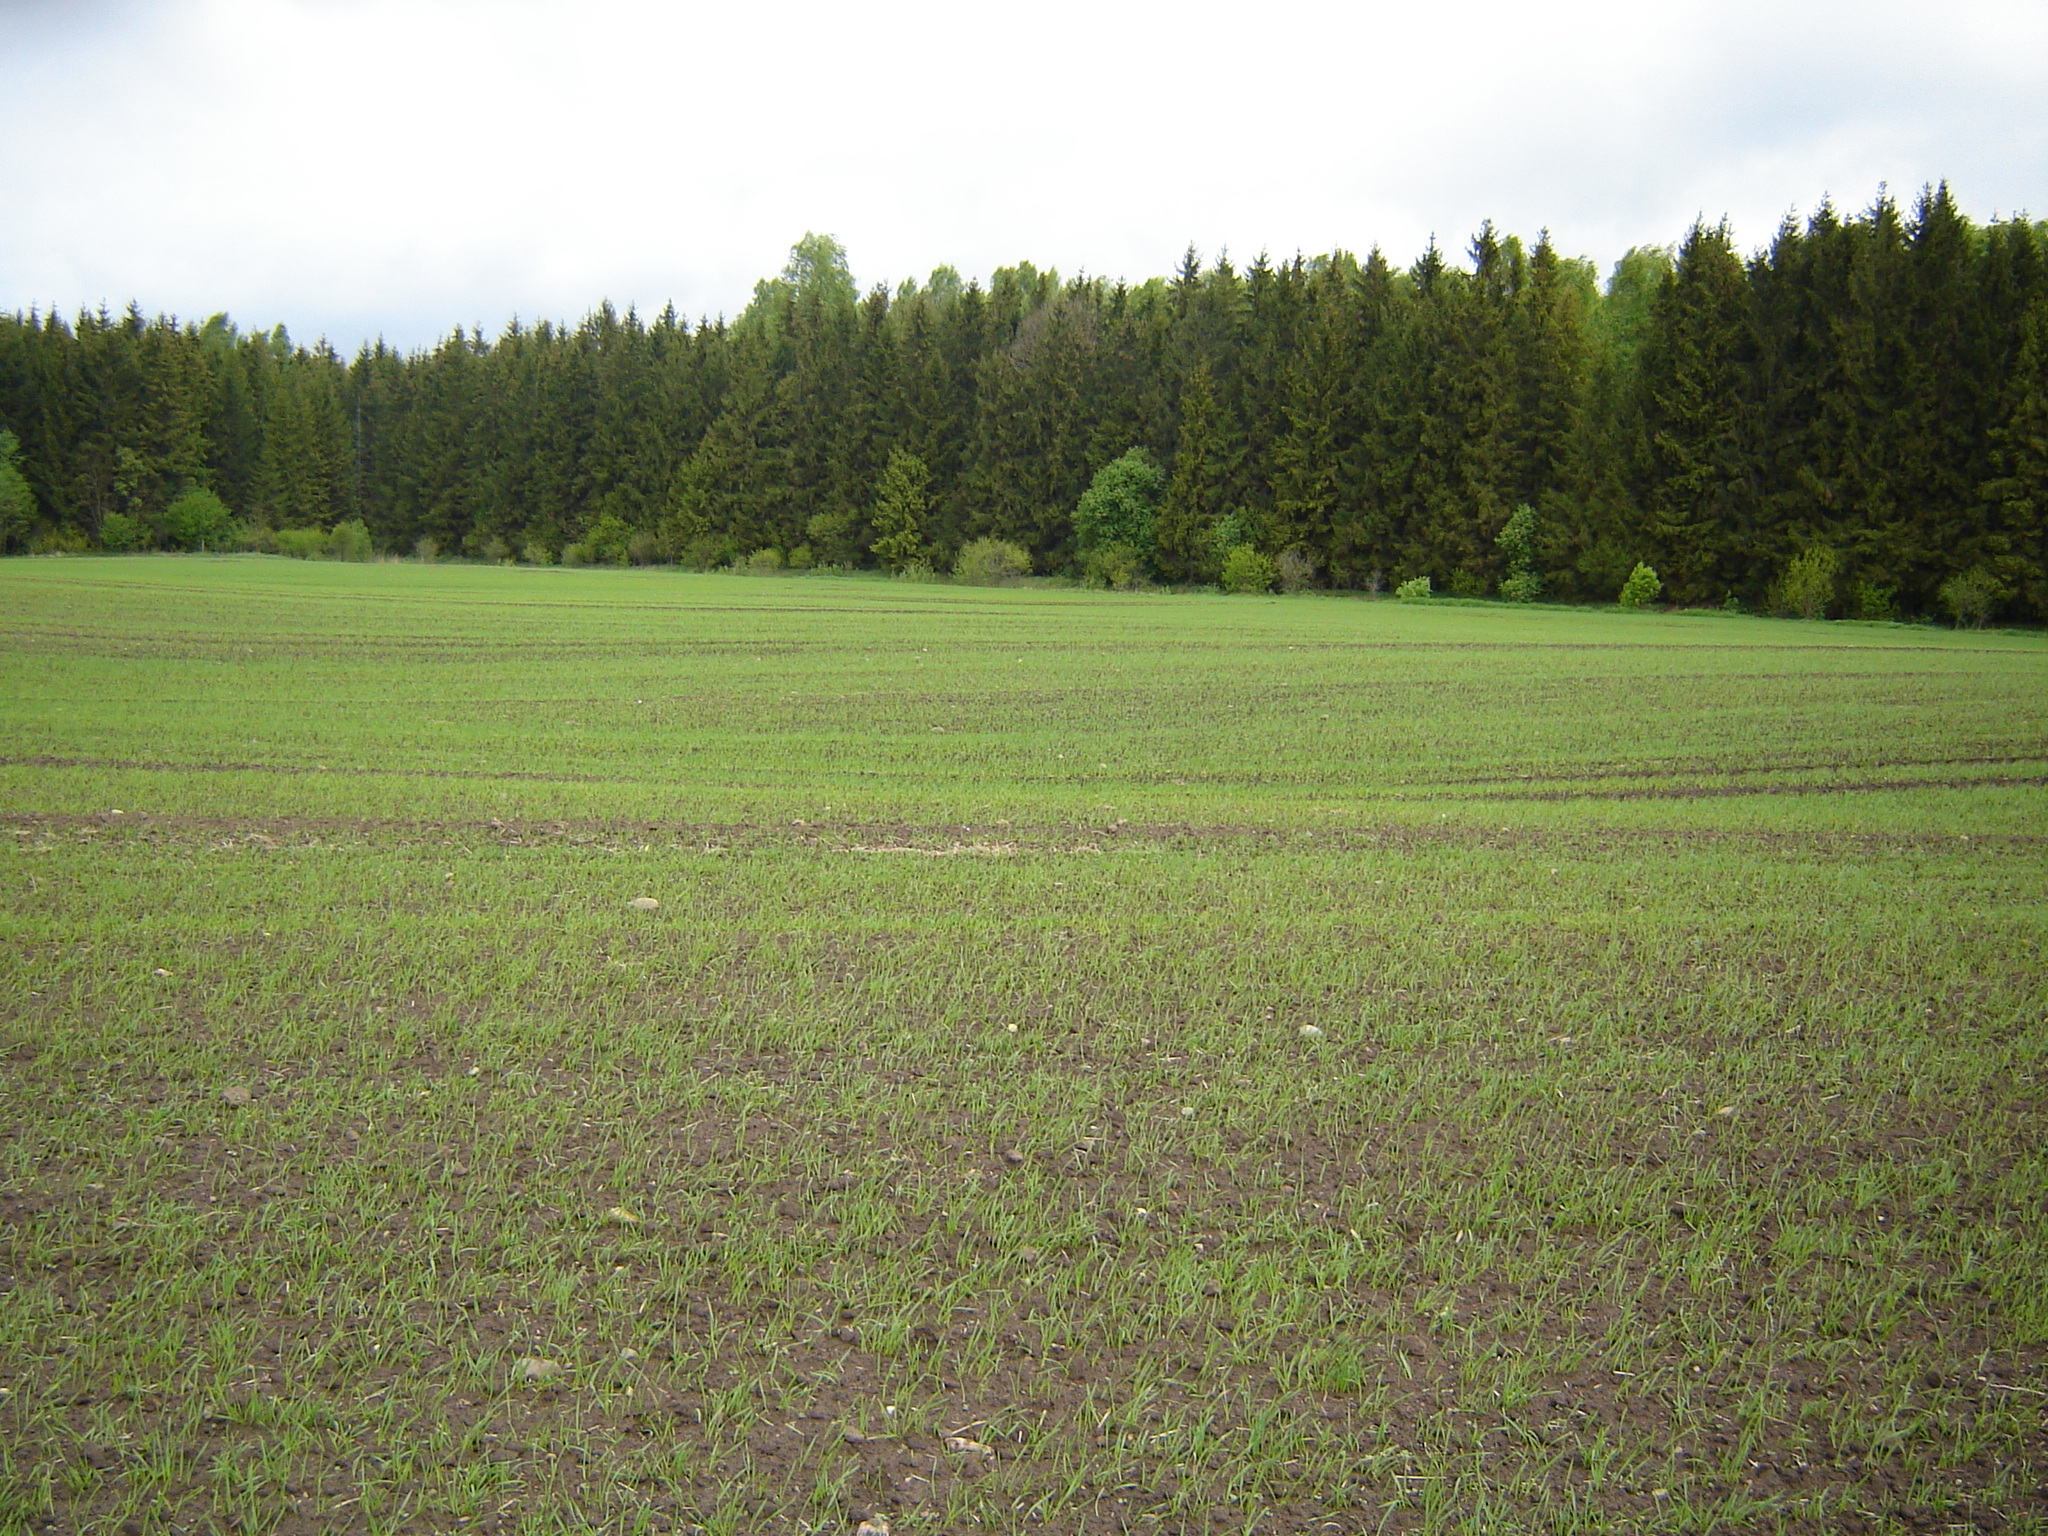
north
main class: Cropland
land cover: Common wheat
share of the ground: 25 - 50 %
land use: Agriculture (excluding fallow land and kitchen gardens)
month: May
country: LT
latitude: 56.0384
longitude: 25.2517
